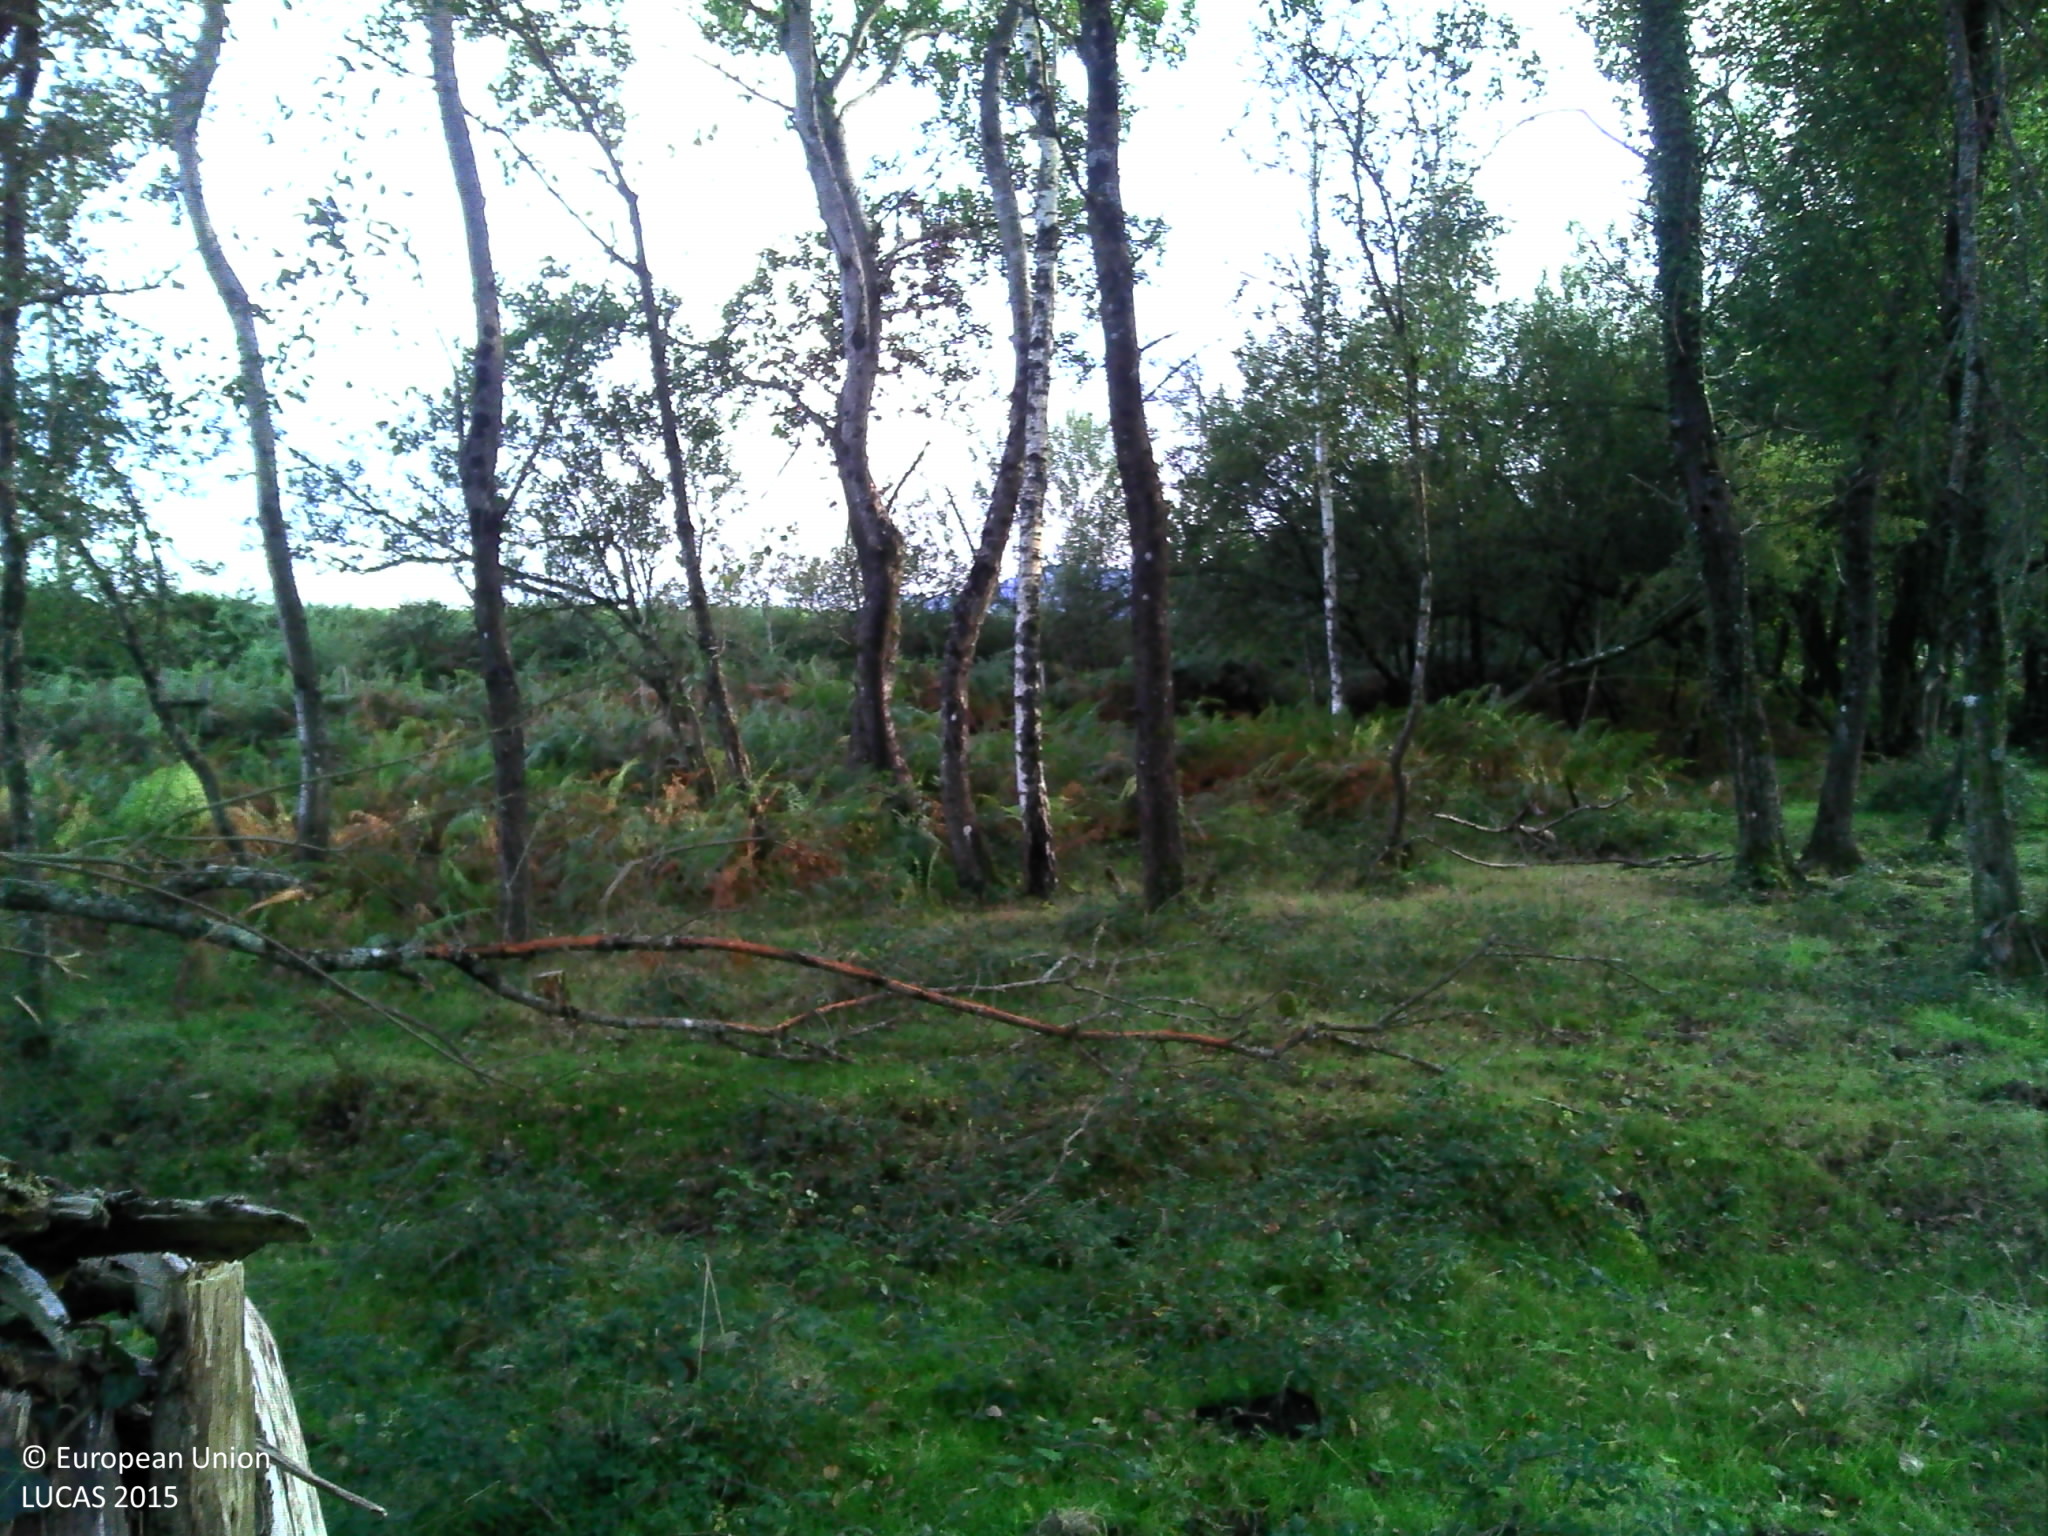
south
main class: Woodland
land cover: Broadleaved woodland
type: exotic forest
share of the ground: 50 - 75 %
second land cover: Grassland without tree/shrub cover
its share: > 75 %
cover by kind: broadleaved forest trees 55 %, herbaceous plants 40 %, lichens and mosses 5 %
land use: Forestry
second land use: Agriculture (excluding fallow land and kitchen gardens)
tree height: > 5 m
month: September
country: FR
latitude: 43.1493
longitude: -0.4461
